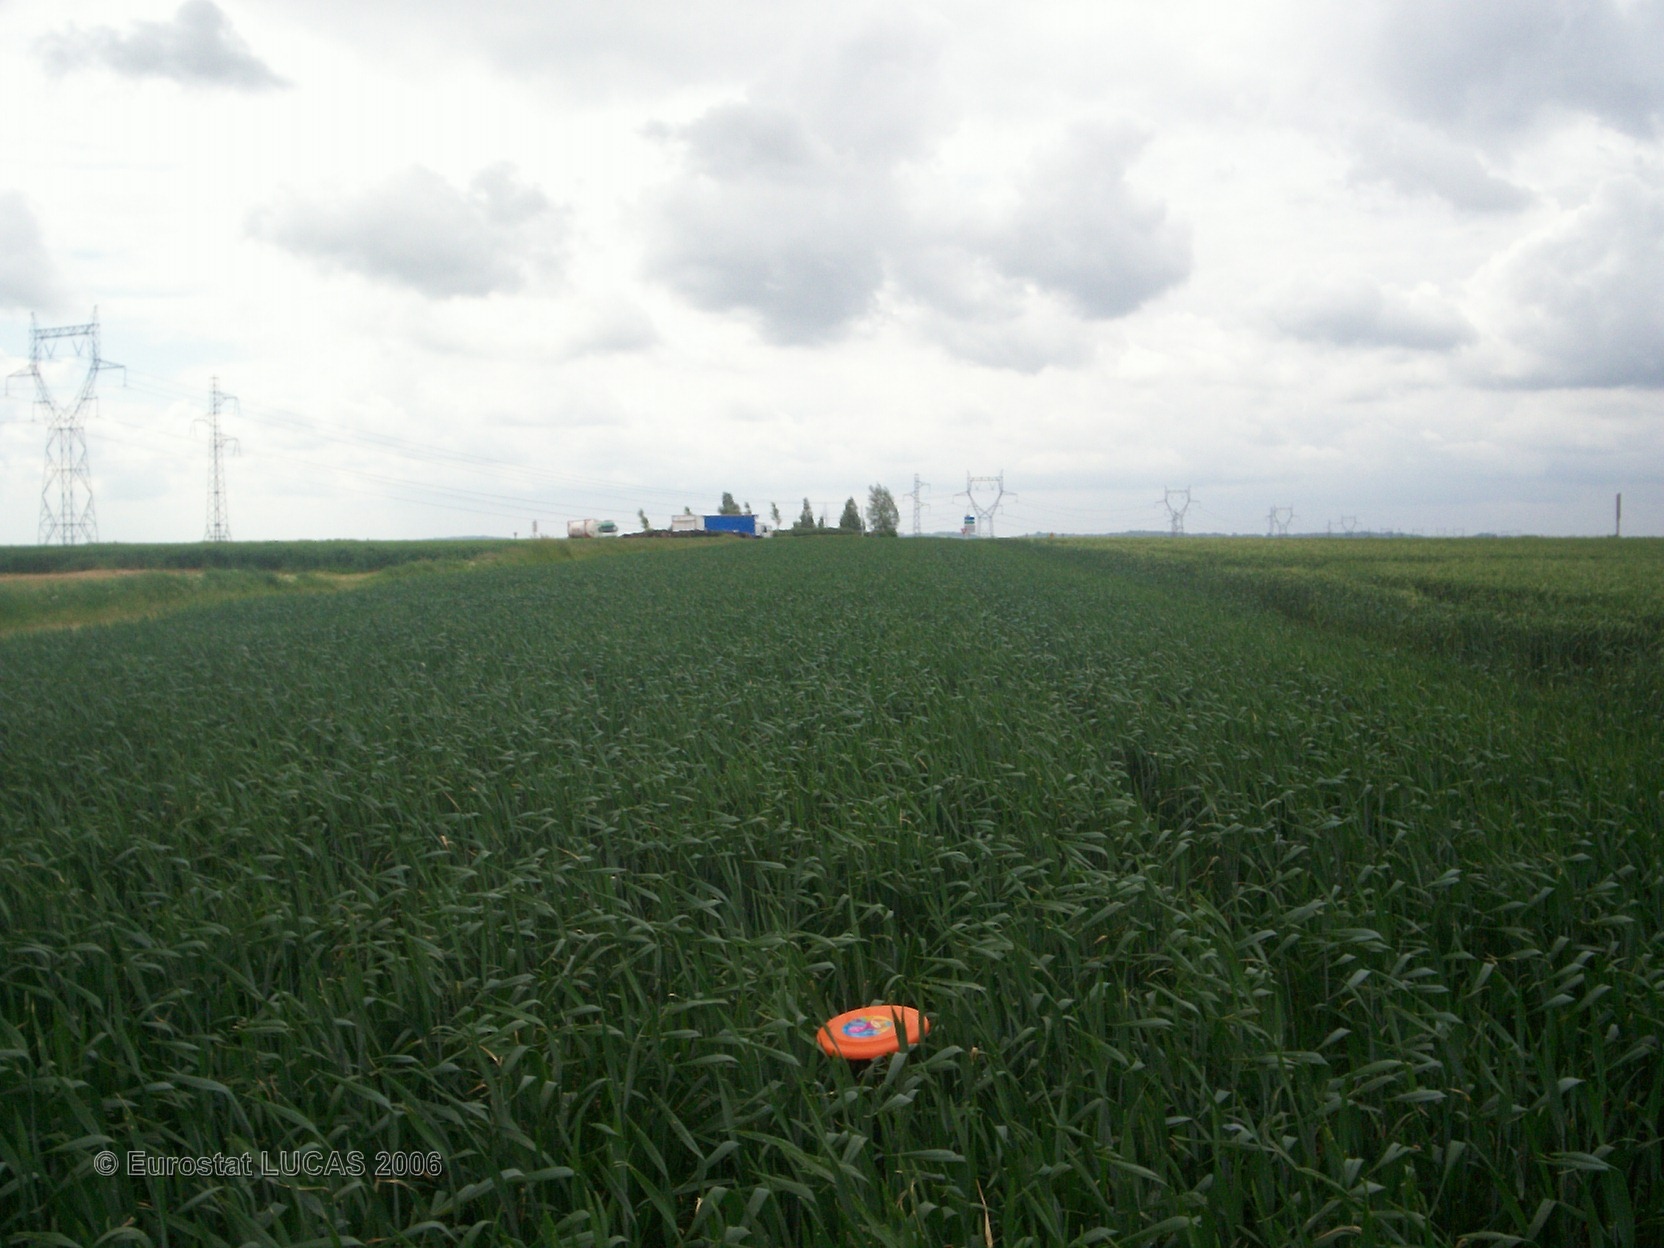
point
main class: Cropland
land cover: Common wheat
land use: Agriculture (excluding fallow land and kitchen gardens)
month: May
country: FR
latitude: 49.1203
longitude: 2.7138
